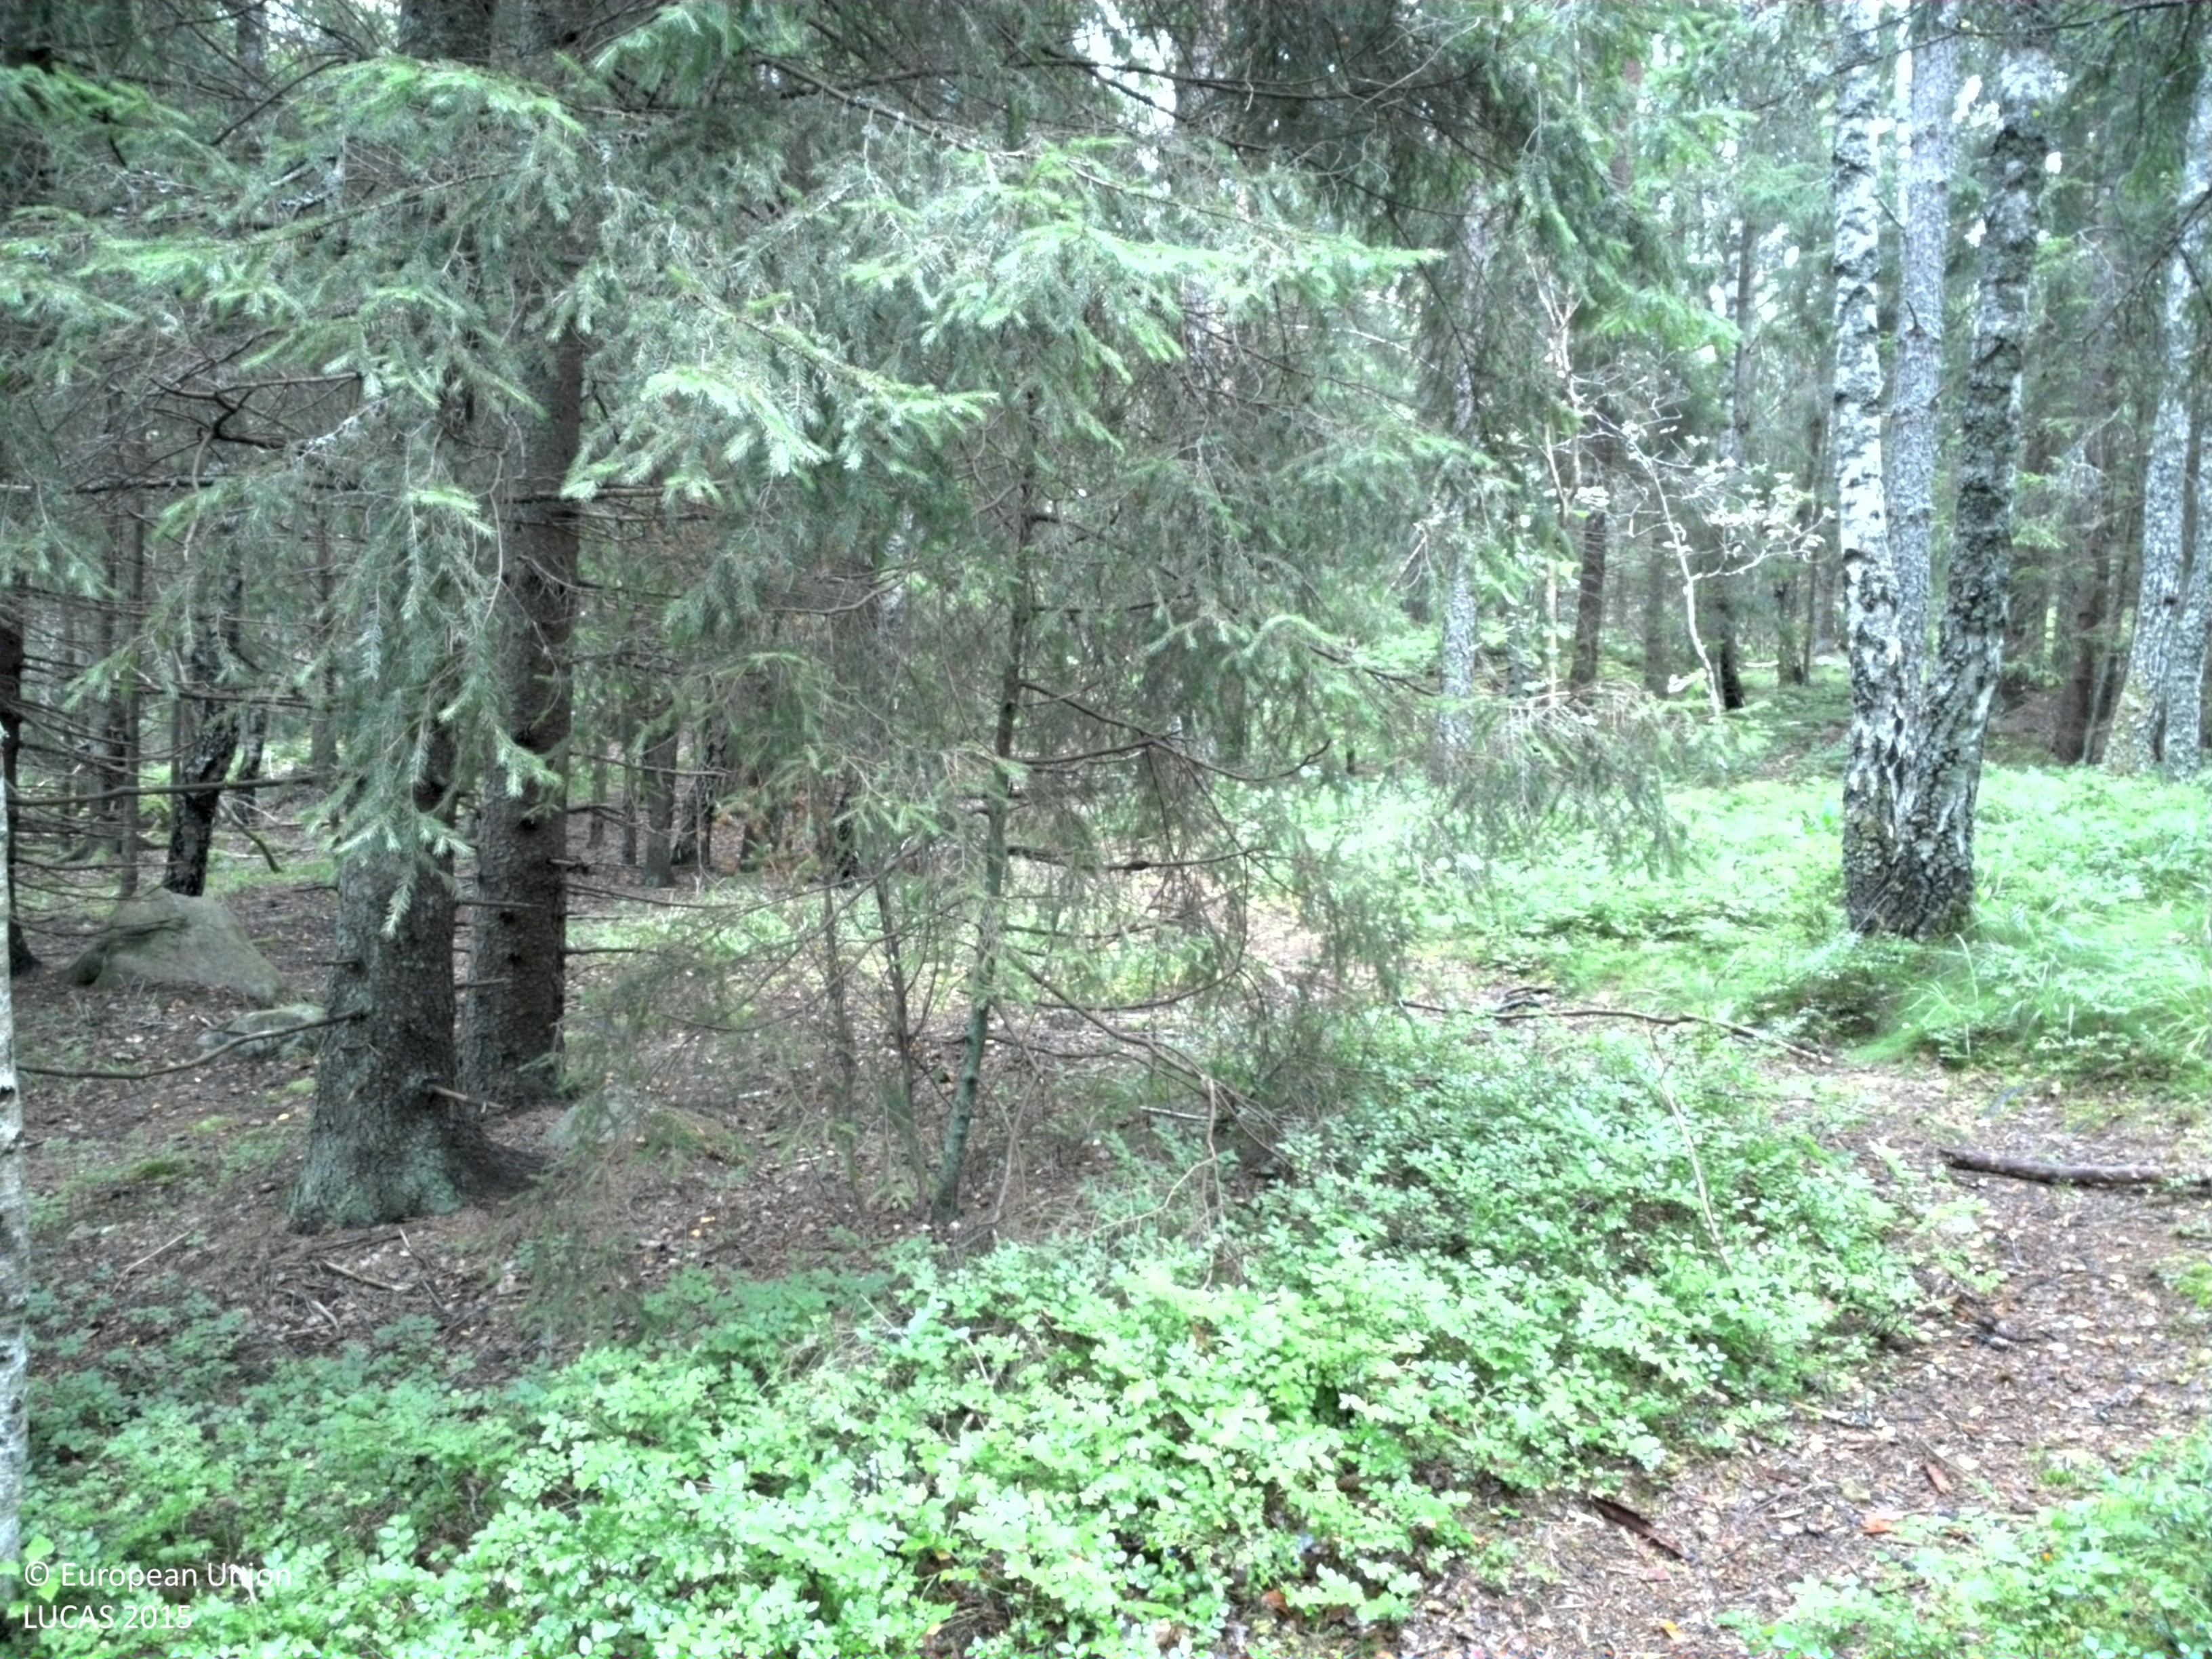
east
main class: Woodland
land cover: Spruce dominated mixed woodland
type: boreal forest
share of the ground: 50 - 75 %
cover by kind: coniferous forest trees 45 %, lichens and mosses 30 %, broadleaved forest trees 15 %, shrubs 10 %
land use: Forestry
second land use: Amenities, museums, leisure
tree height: > 5 m
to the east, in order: Spruce dominated mixed woodland; Tracks; Spruce dominated mixed woodland; Pine dominated coniferous woodland; Pine dominated mixed woodland
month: July
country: SE
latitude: 59.5001
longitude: 18.3190
